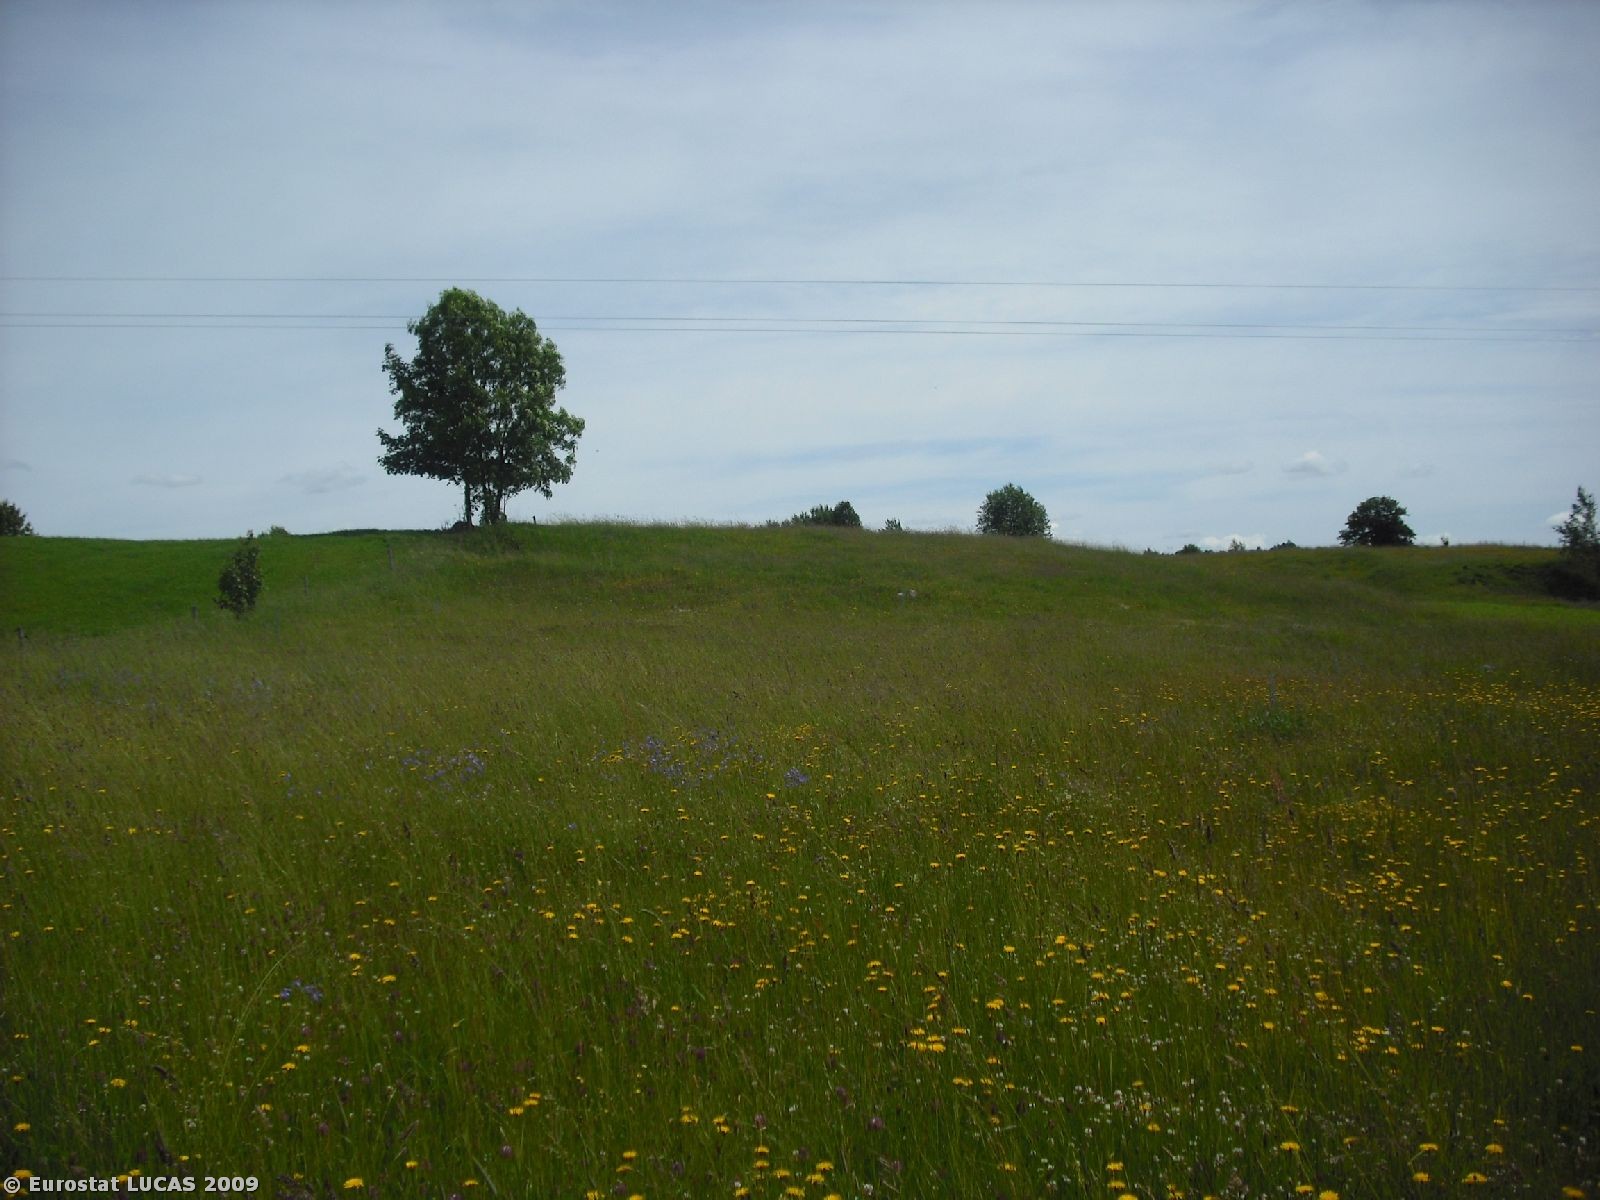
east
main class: Grassland
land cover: Grassland without tree/shrub cover
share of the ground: > 75 %
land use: Agriculture (excluding fallow land and kitchen gardens)
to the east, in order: Grassland without tree/shrub cover; Electric lines; Grassland without tree/shrub cover; Oats; Grassland without tree/shrub cover
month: June
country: PL
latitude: 54.2967
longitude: 22.8698
